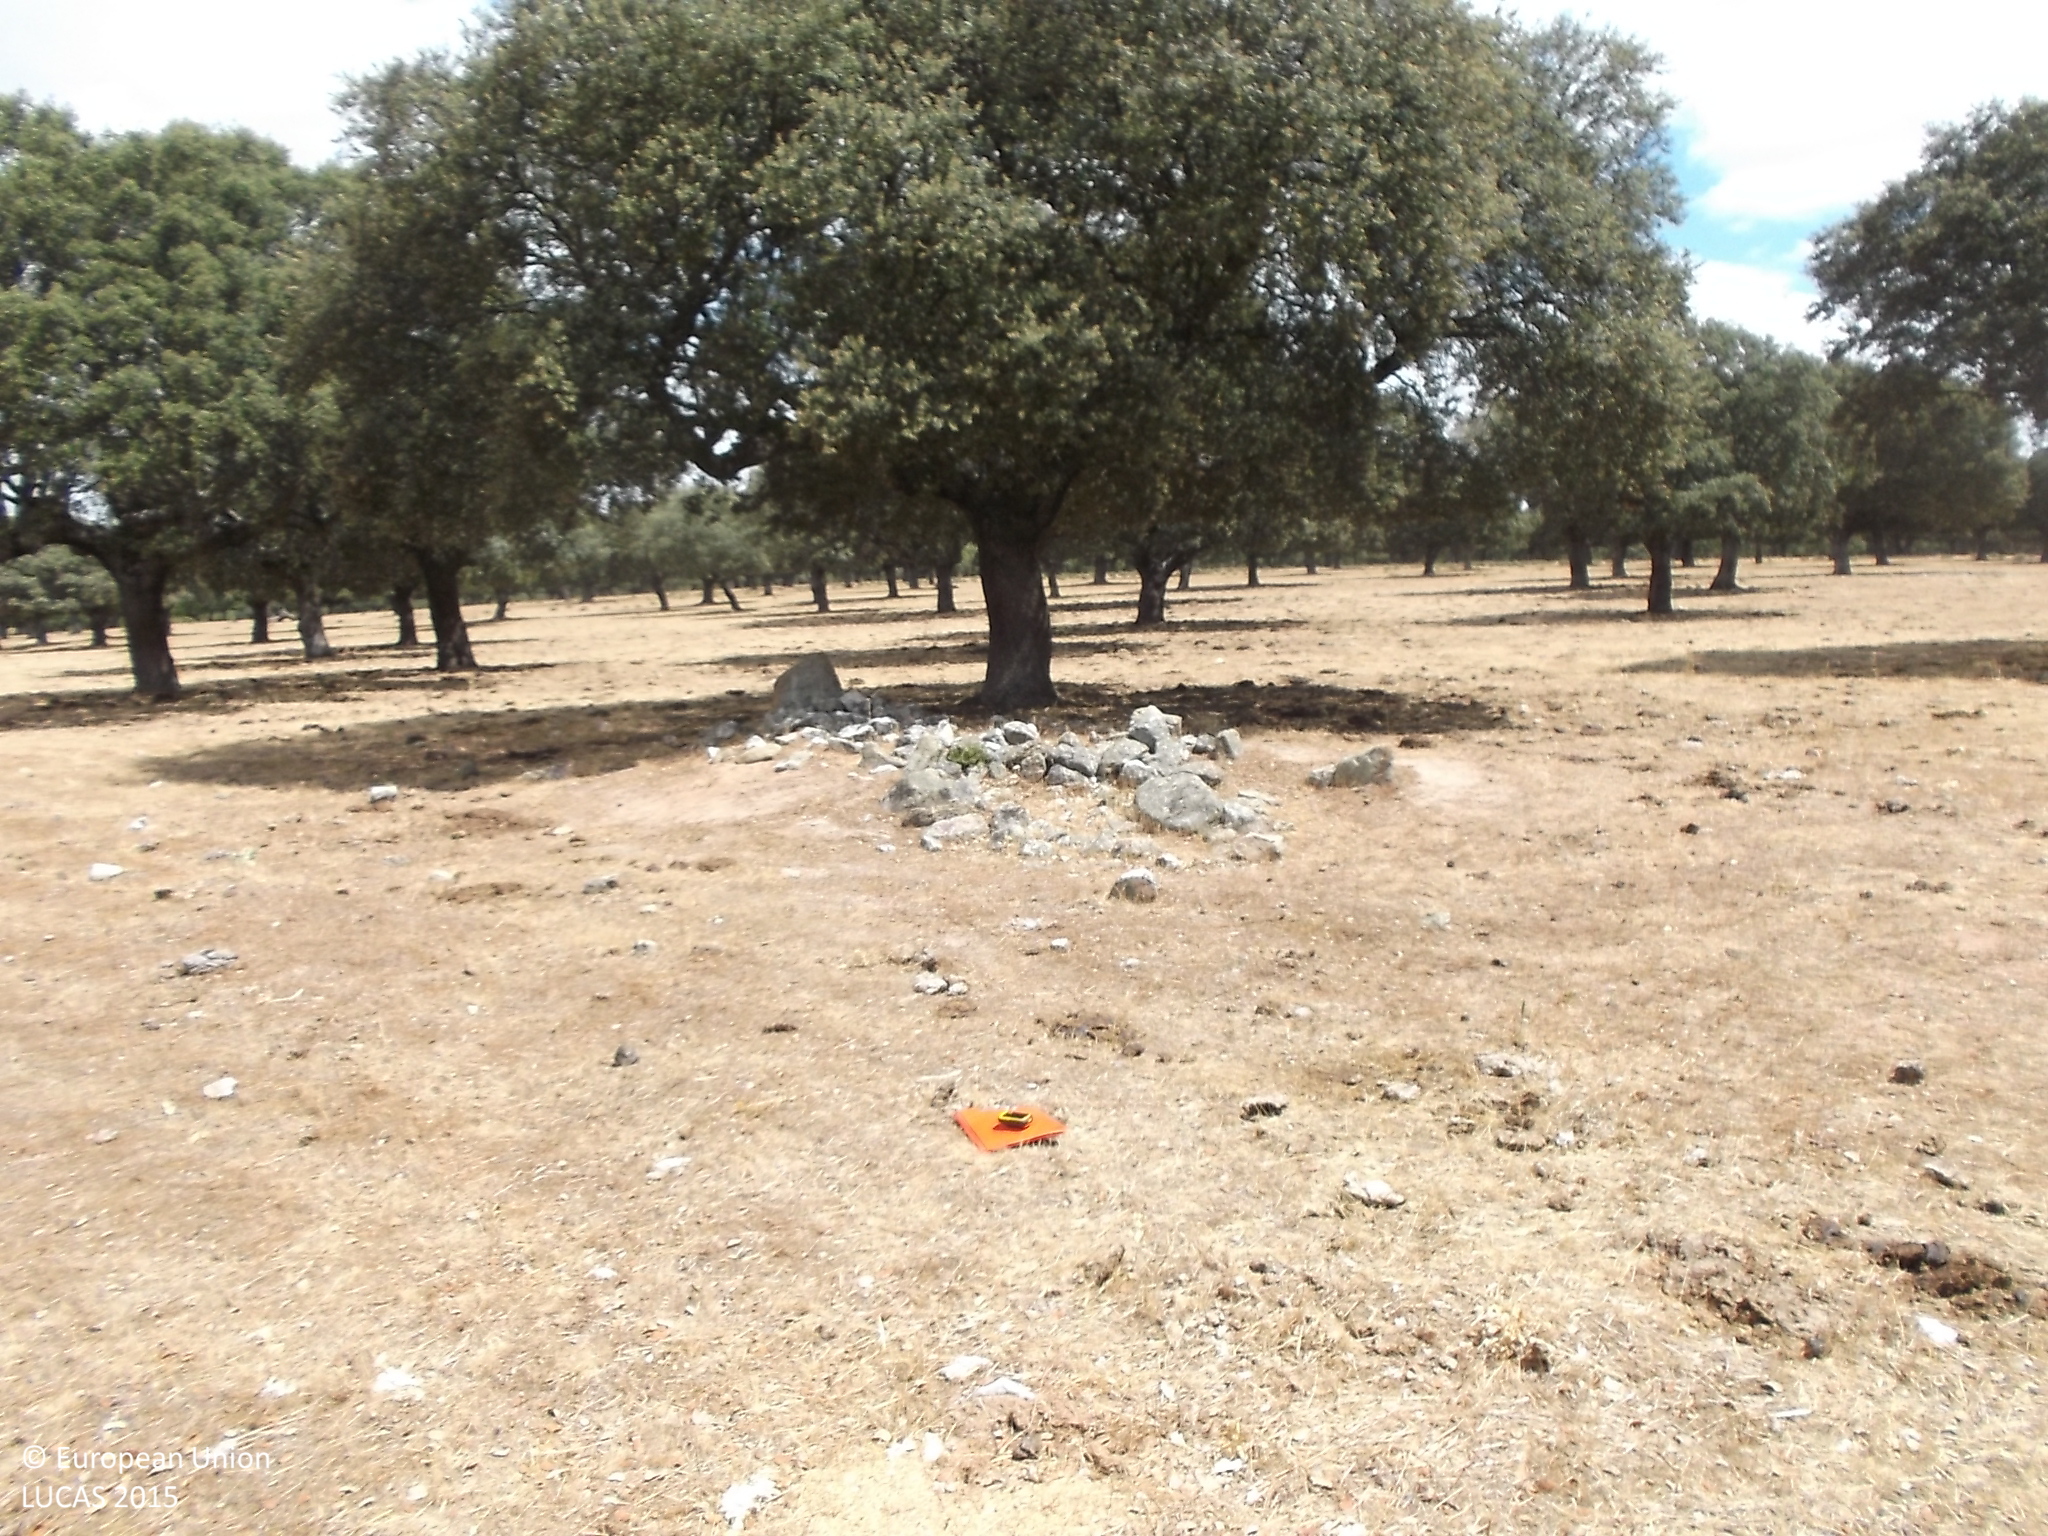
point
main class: Woodland
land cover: Broadleaved woodland
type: broadleaved evergreen forest
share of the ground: 25 - 50 %
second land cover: Grassland without tree/shrub cover
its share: 50 - 75 %
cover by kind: herbaceous plants 60 %, broadleaved forest trees 40 %
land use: Forestry
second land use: Agriculture (excluding fallow land and kitchen gardens)
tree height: < 5 m
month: July
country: ES
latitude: 40.9249
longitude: -6.3720
